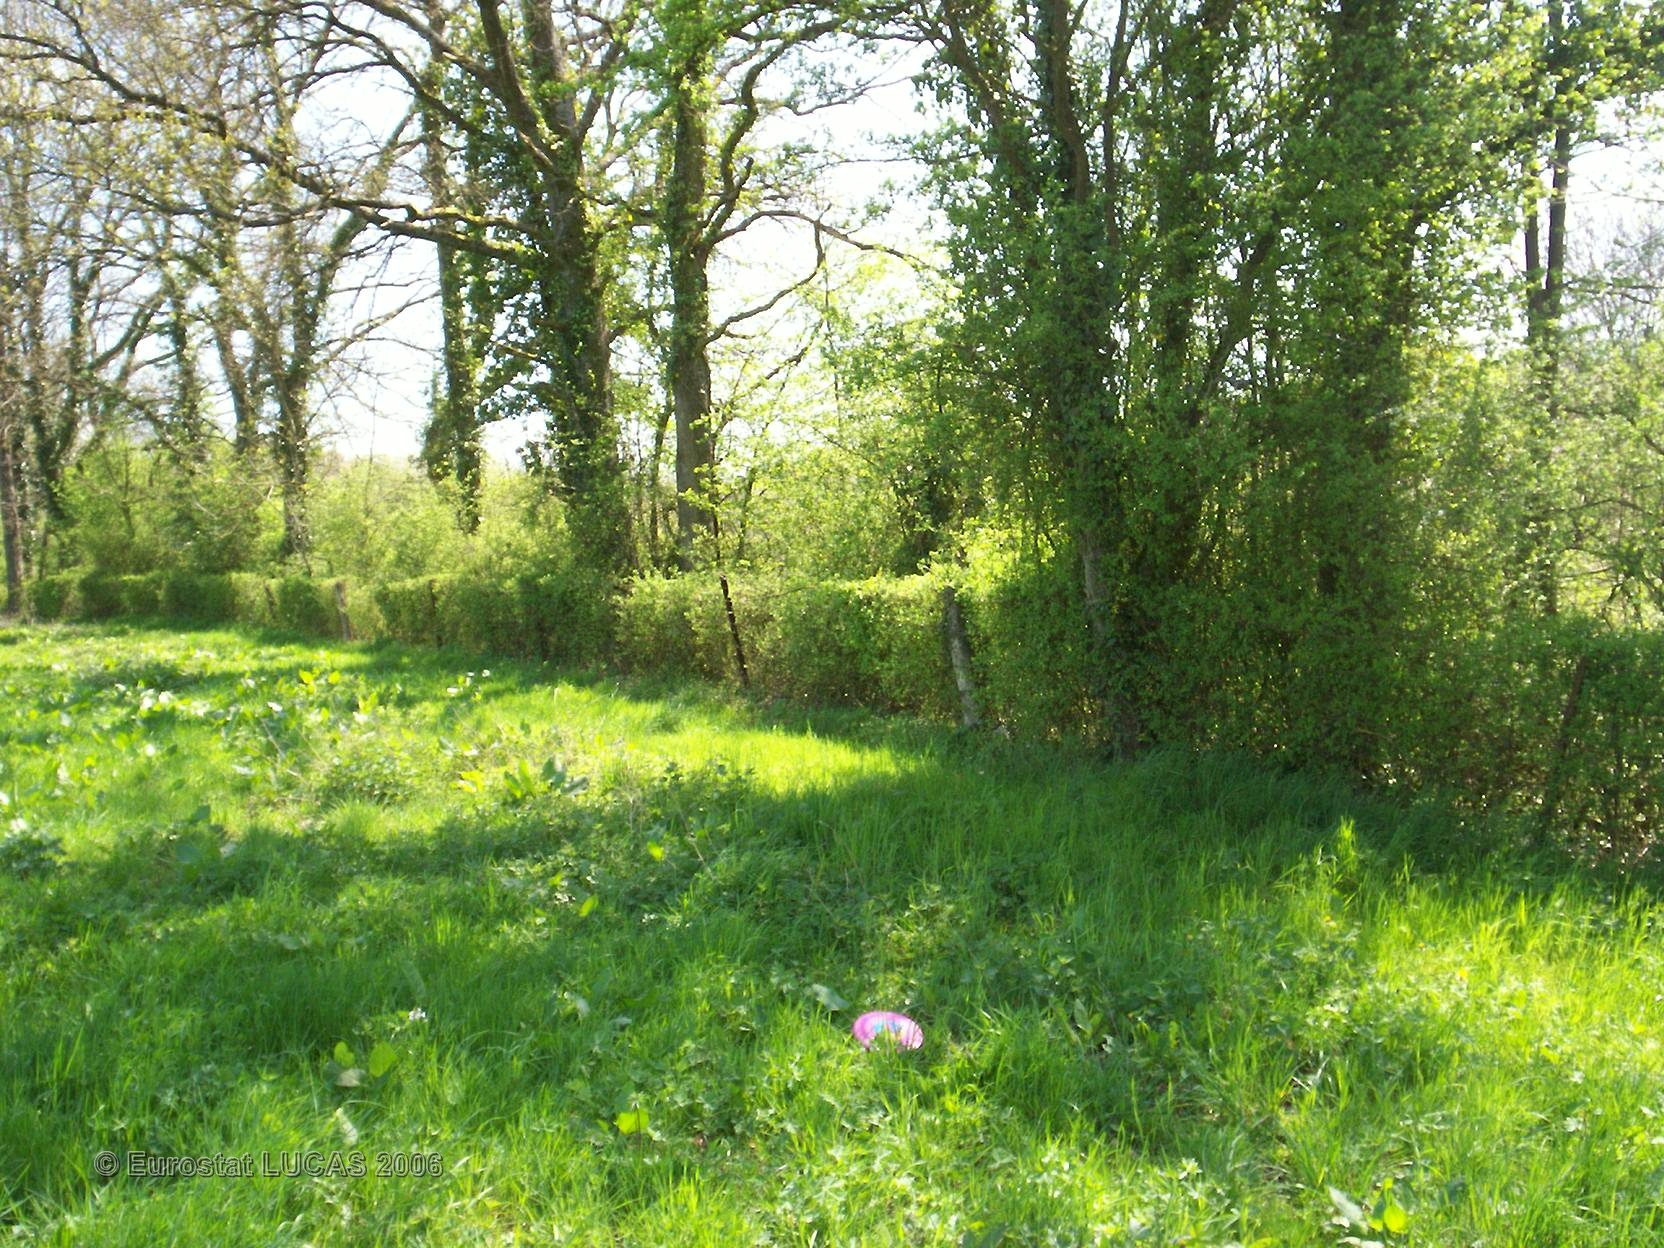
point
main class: Grassland
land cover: Grassland without tree/shrub cover
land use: Agriculture (excluding fallow land and kitchen gardens)
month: April
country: FR
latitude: 49.6673
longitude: 4.3844
